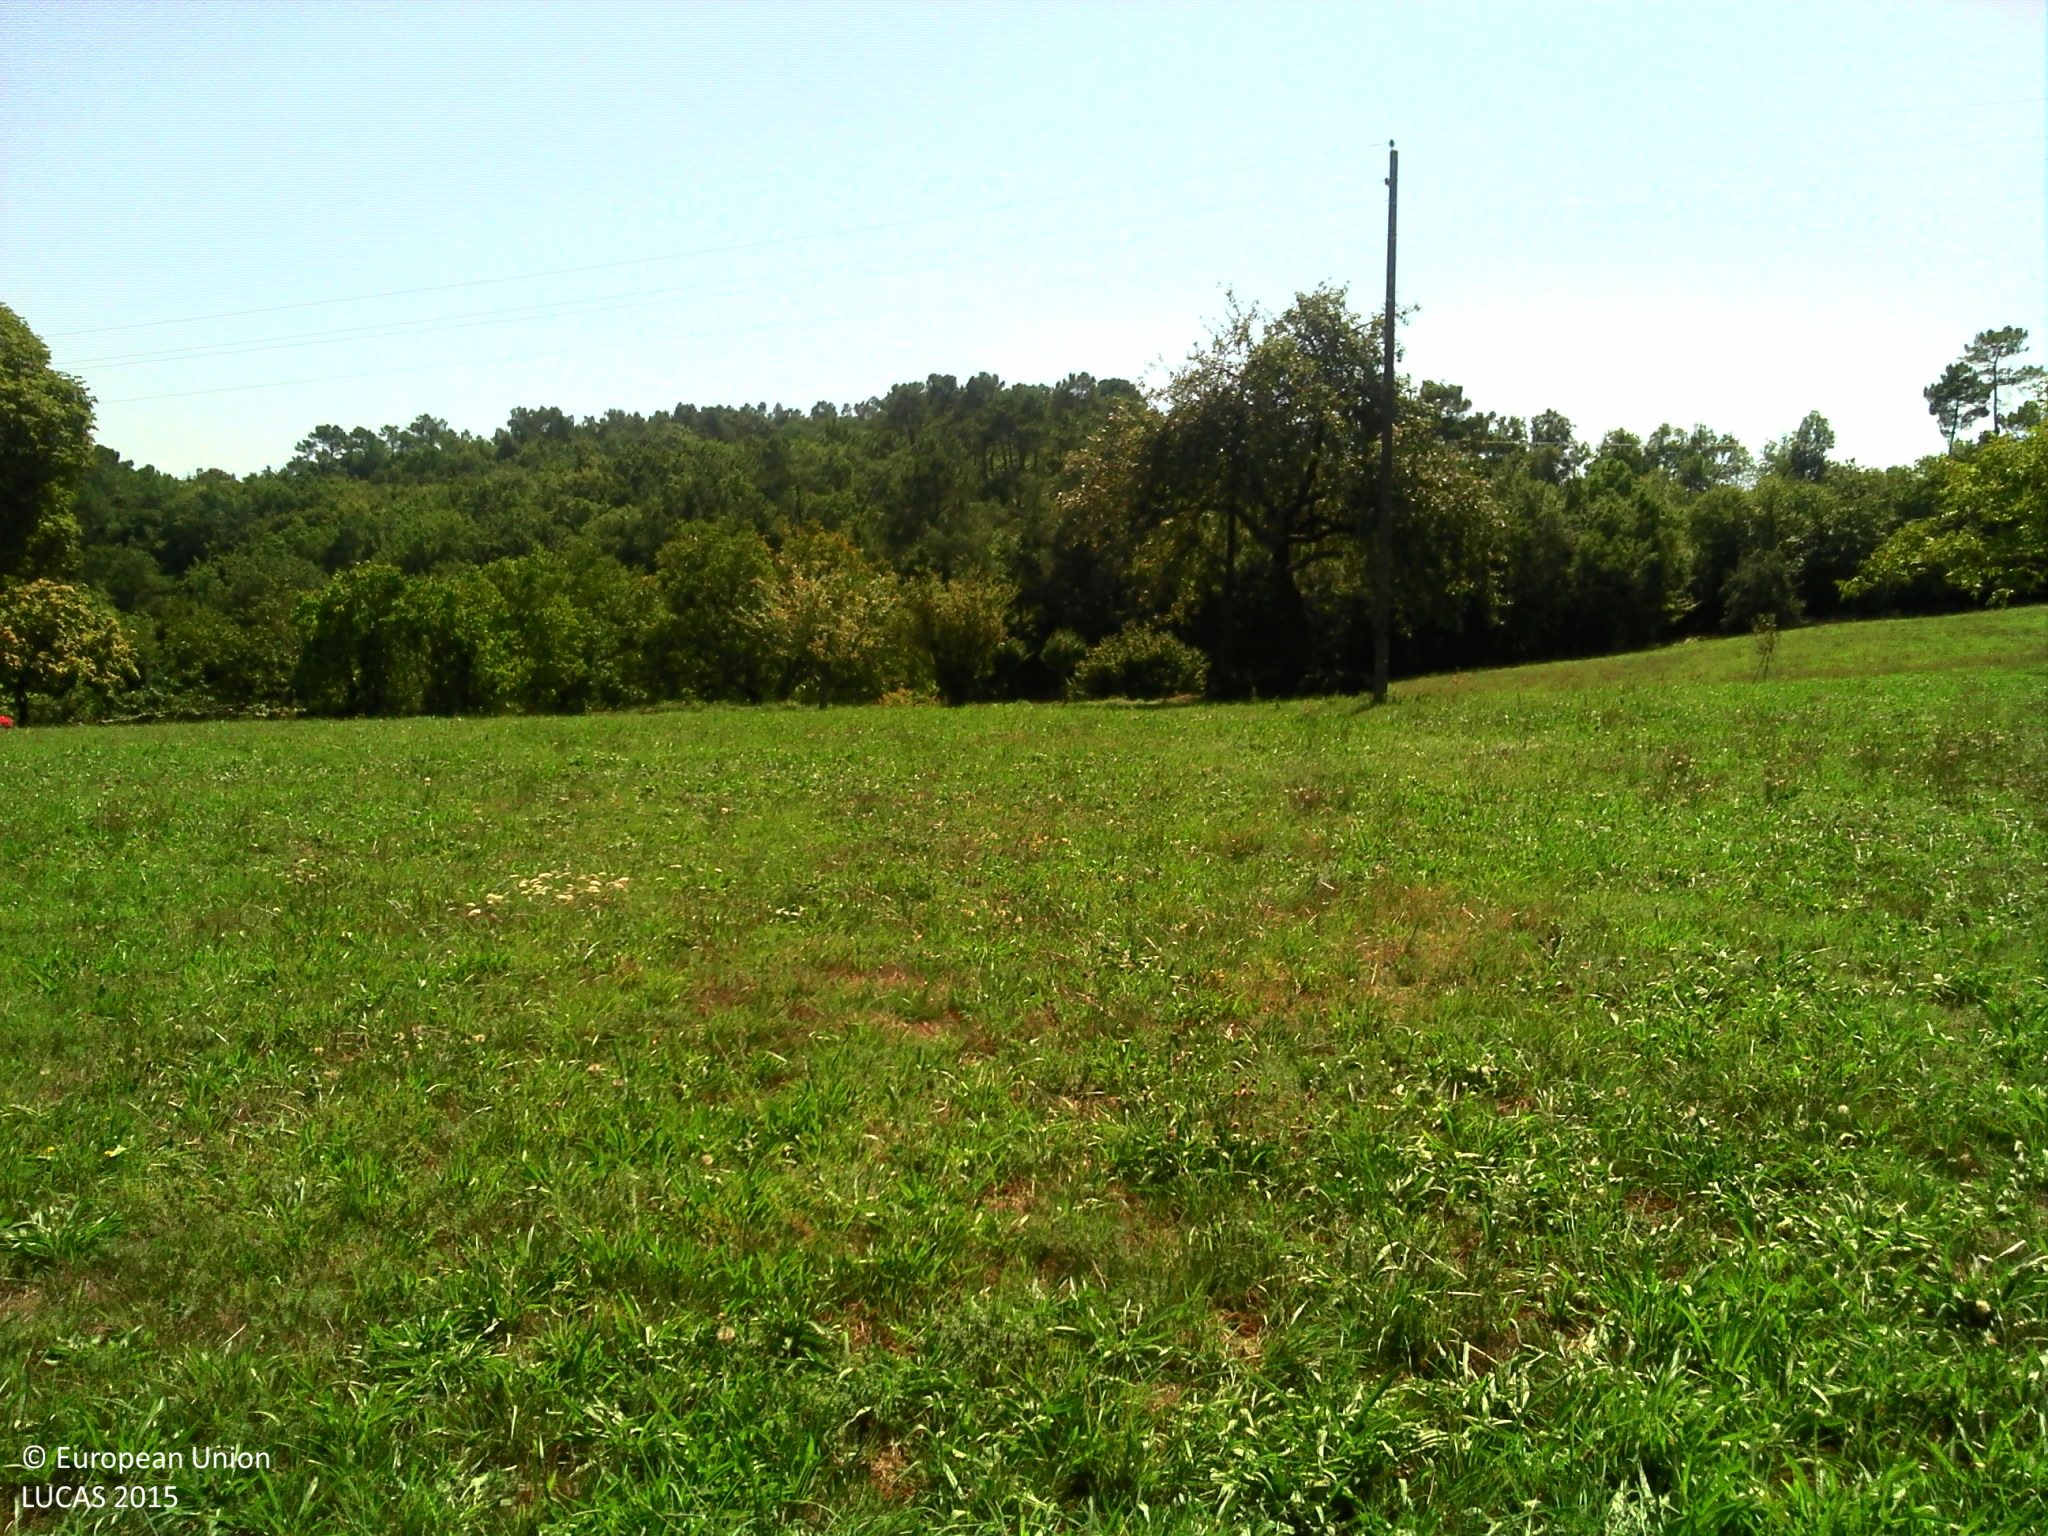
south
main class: Grassland
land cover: Grassland without tree/shrub cover
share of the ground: > 75 %
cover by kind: herbaceous plants 100 %
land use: Agriculture (excluding fallow land and kitchen gardens)
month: August
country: FR
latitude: 44.5739
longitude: 1.1937
